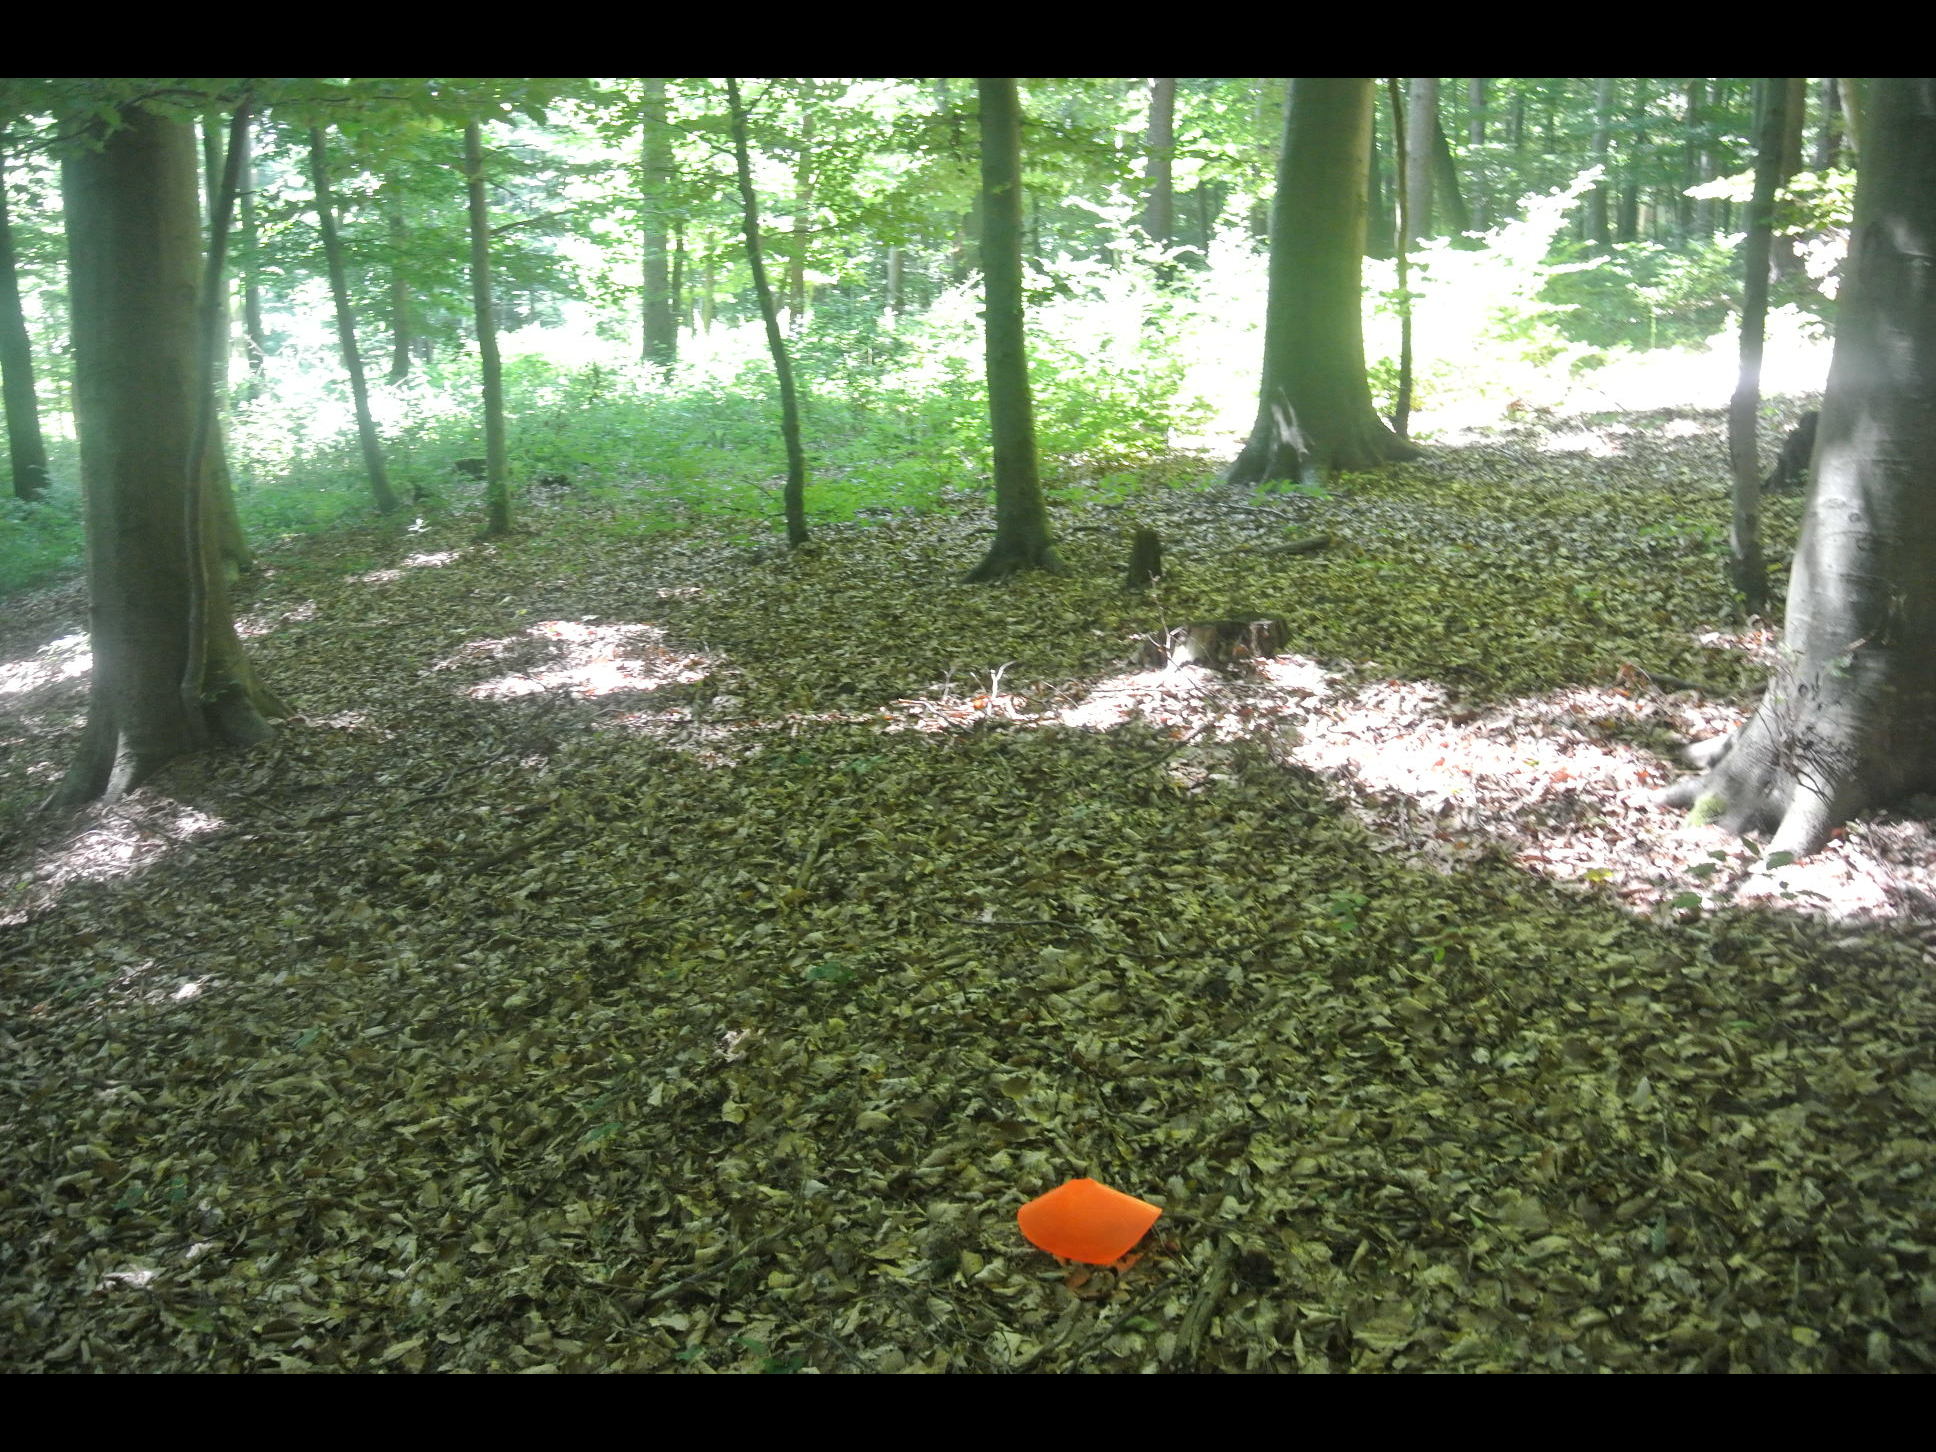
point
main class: Woodland
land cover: Broadleaved woodland
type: beech forest
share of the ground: > 75 %
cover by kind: broadleaved forest trees 100 %
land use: Forestry
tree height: > 5 m
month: July
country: AT
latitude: 47.6369
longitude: 16.4592
